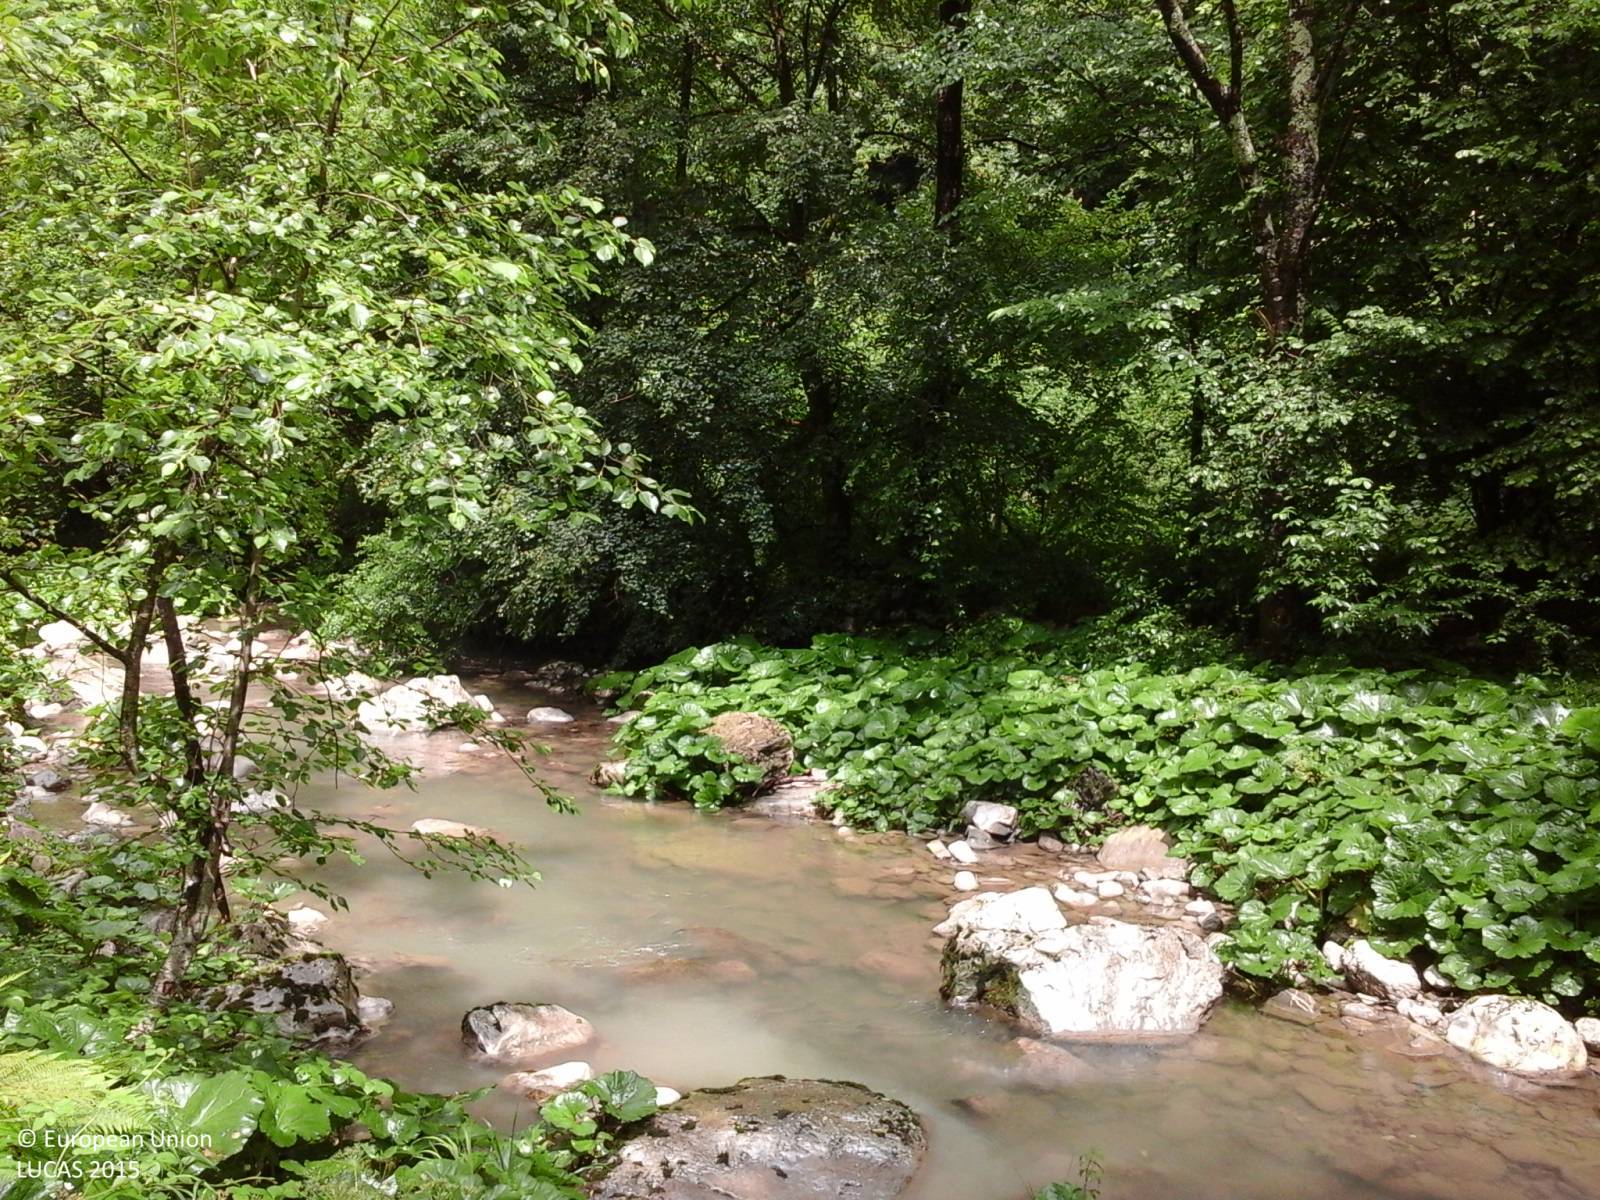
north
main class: Woodland
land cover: Broadleaved woodland
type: thermophilous deciduous forest
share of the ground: > 75 %
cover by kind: broadleaved forest trees 70 %, coniferous forest trees 10 %, shrubs 10 %, herbaceous plants 10 %
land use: Forestry
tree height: > 5 m
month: June
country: IT
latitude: 46.2453
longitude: 13.3299
